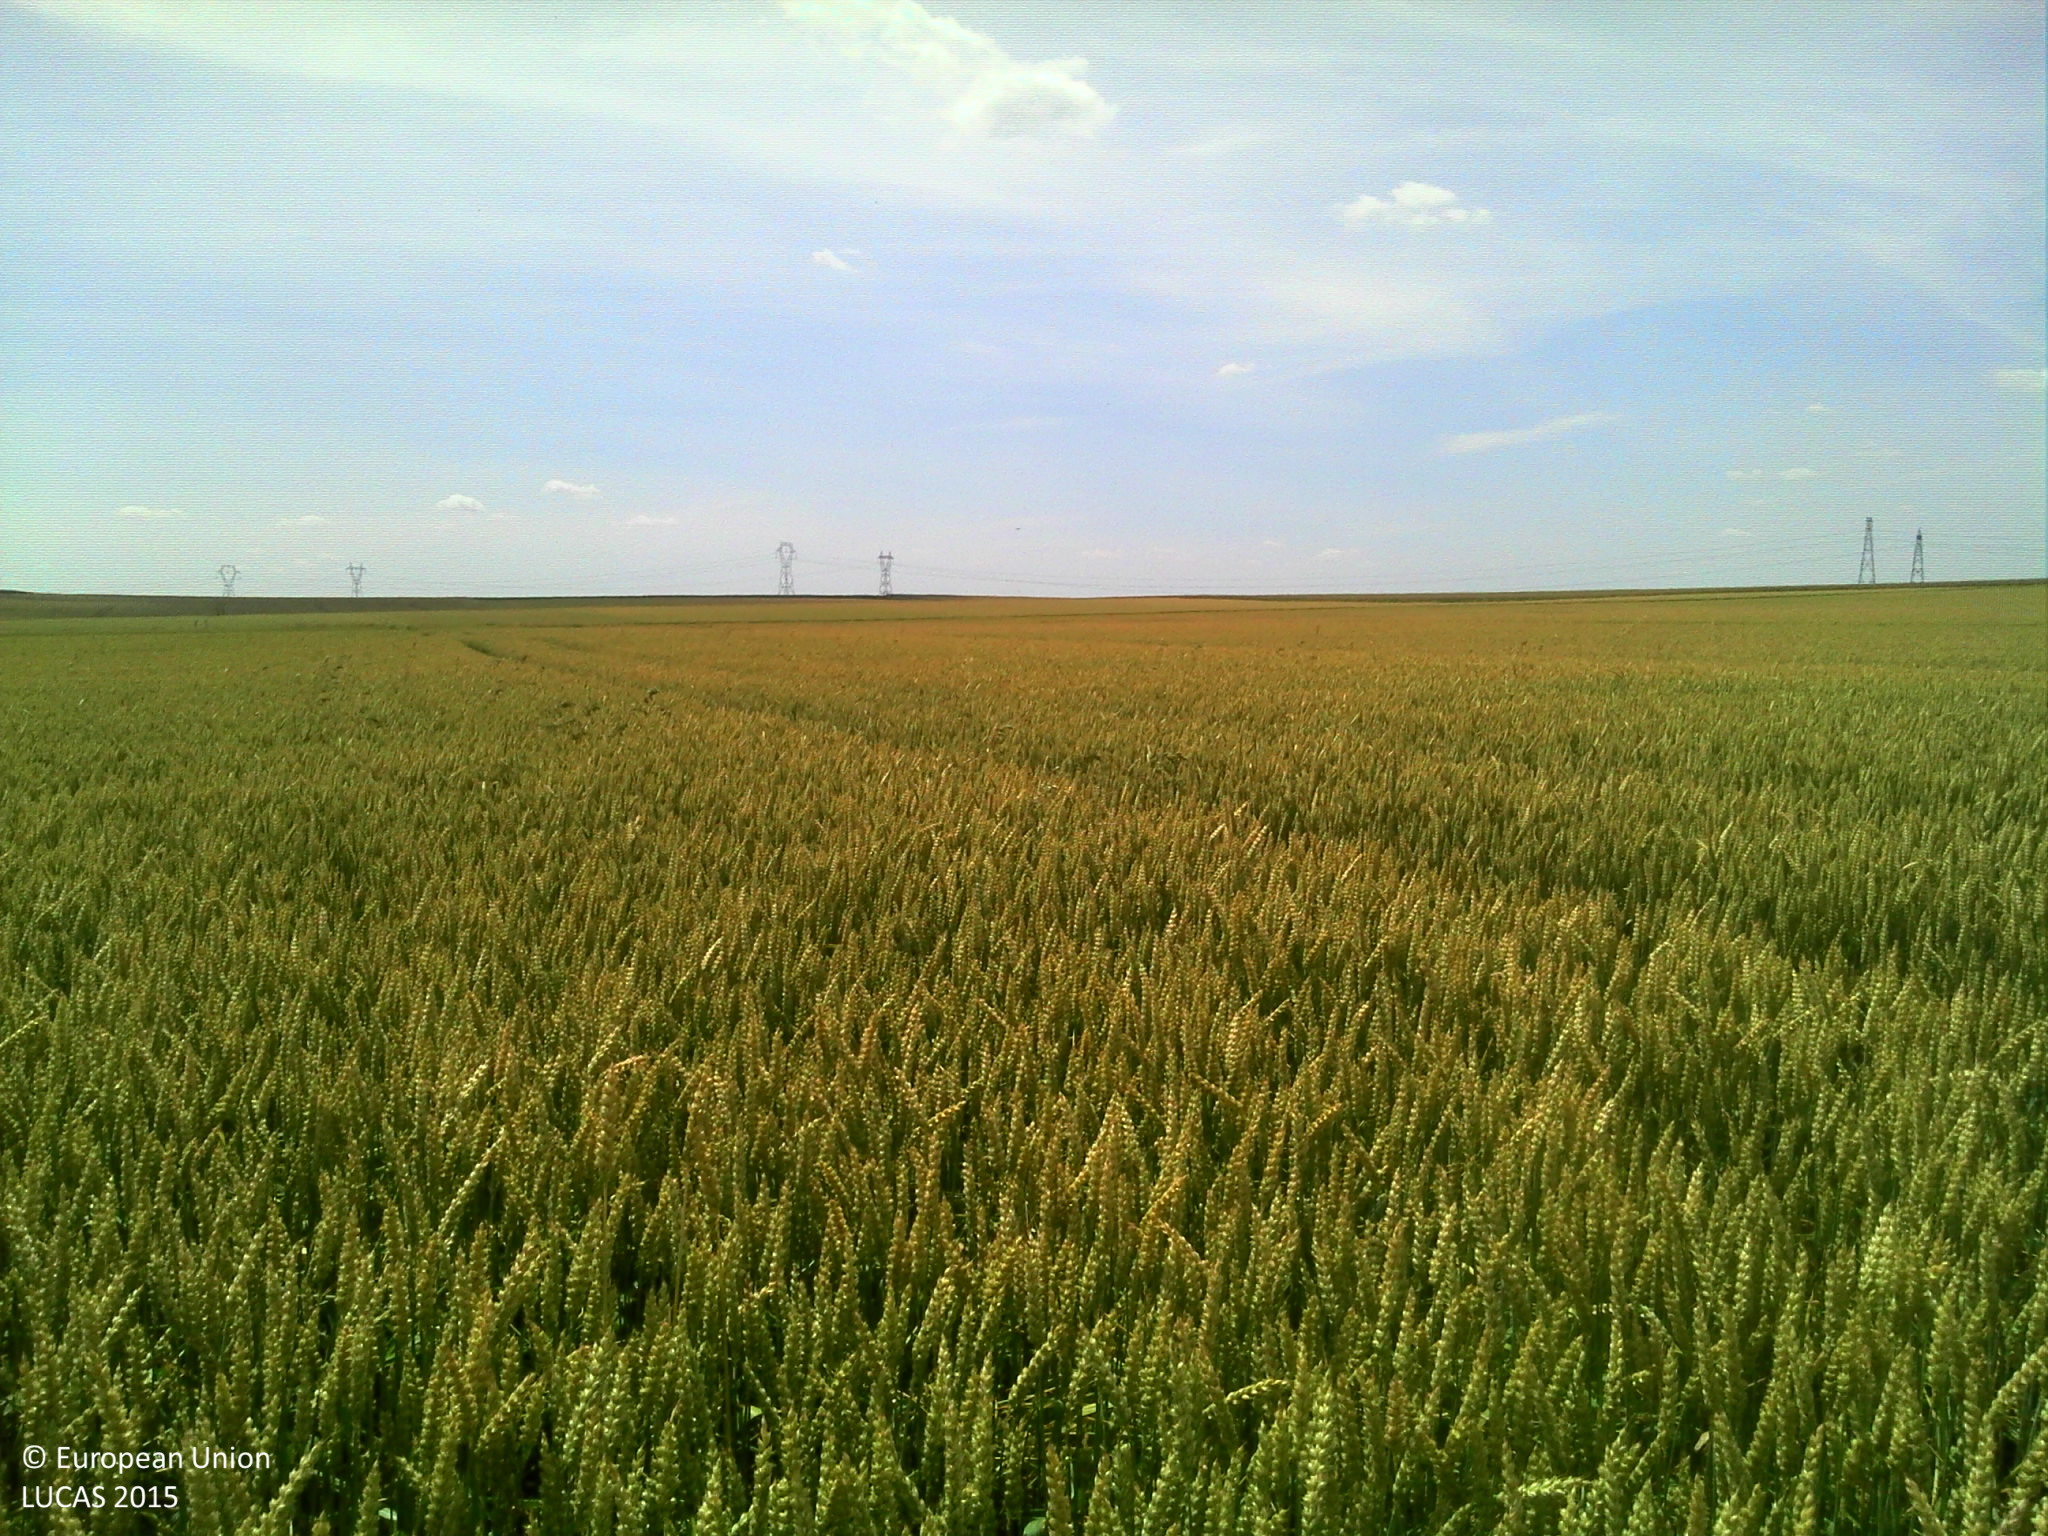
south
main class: Cropland
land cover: Common wheat
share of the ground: > 75 %
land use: Agriculture (excluding fallow land and kitchen gardens)
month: June
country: FR
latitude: 47.9969
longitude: 3.5220
